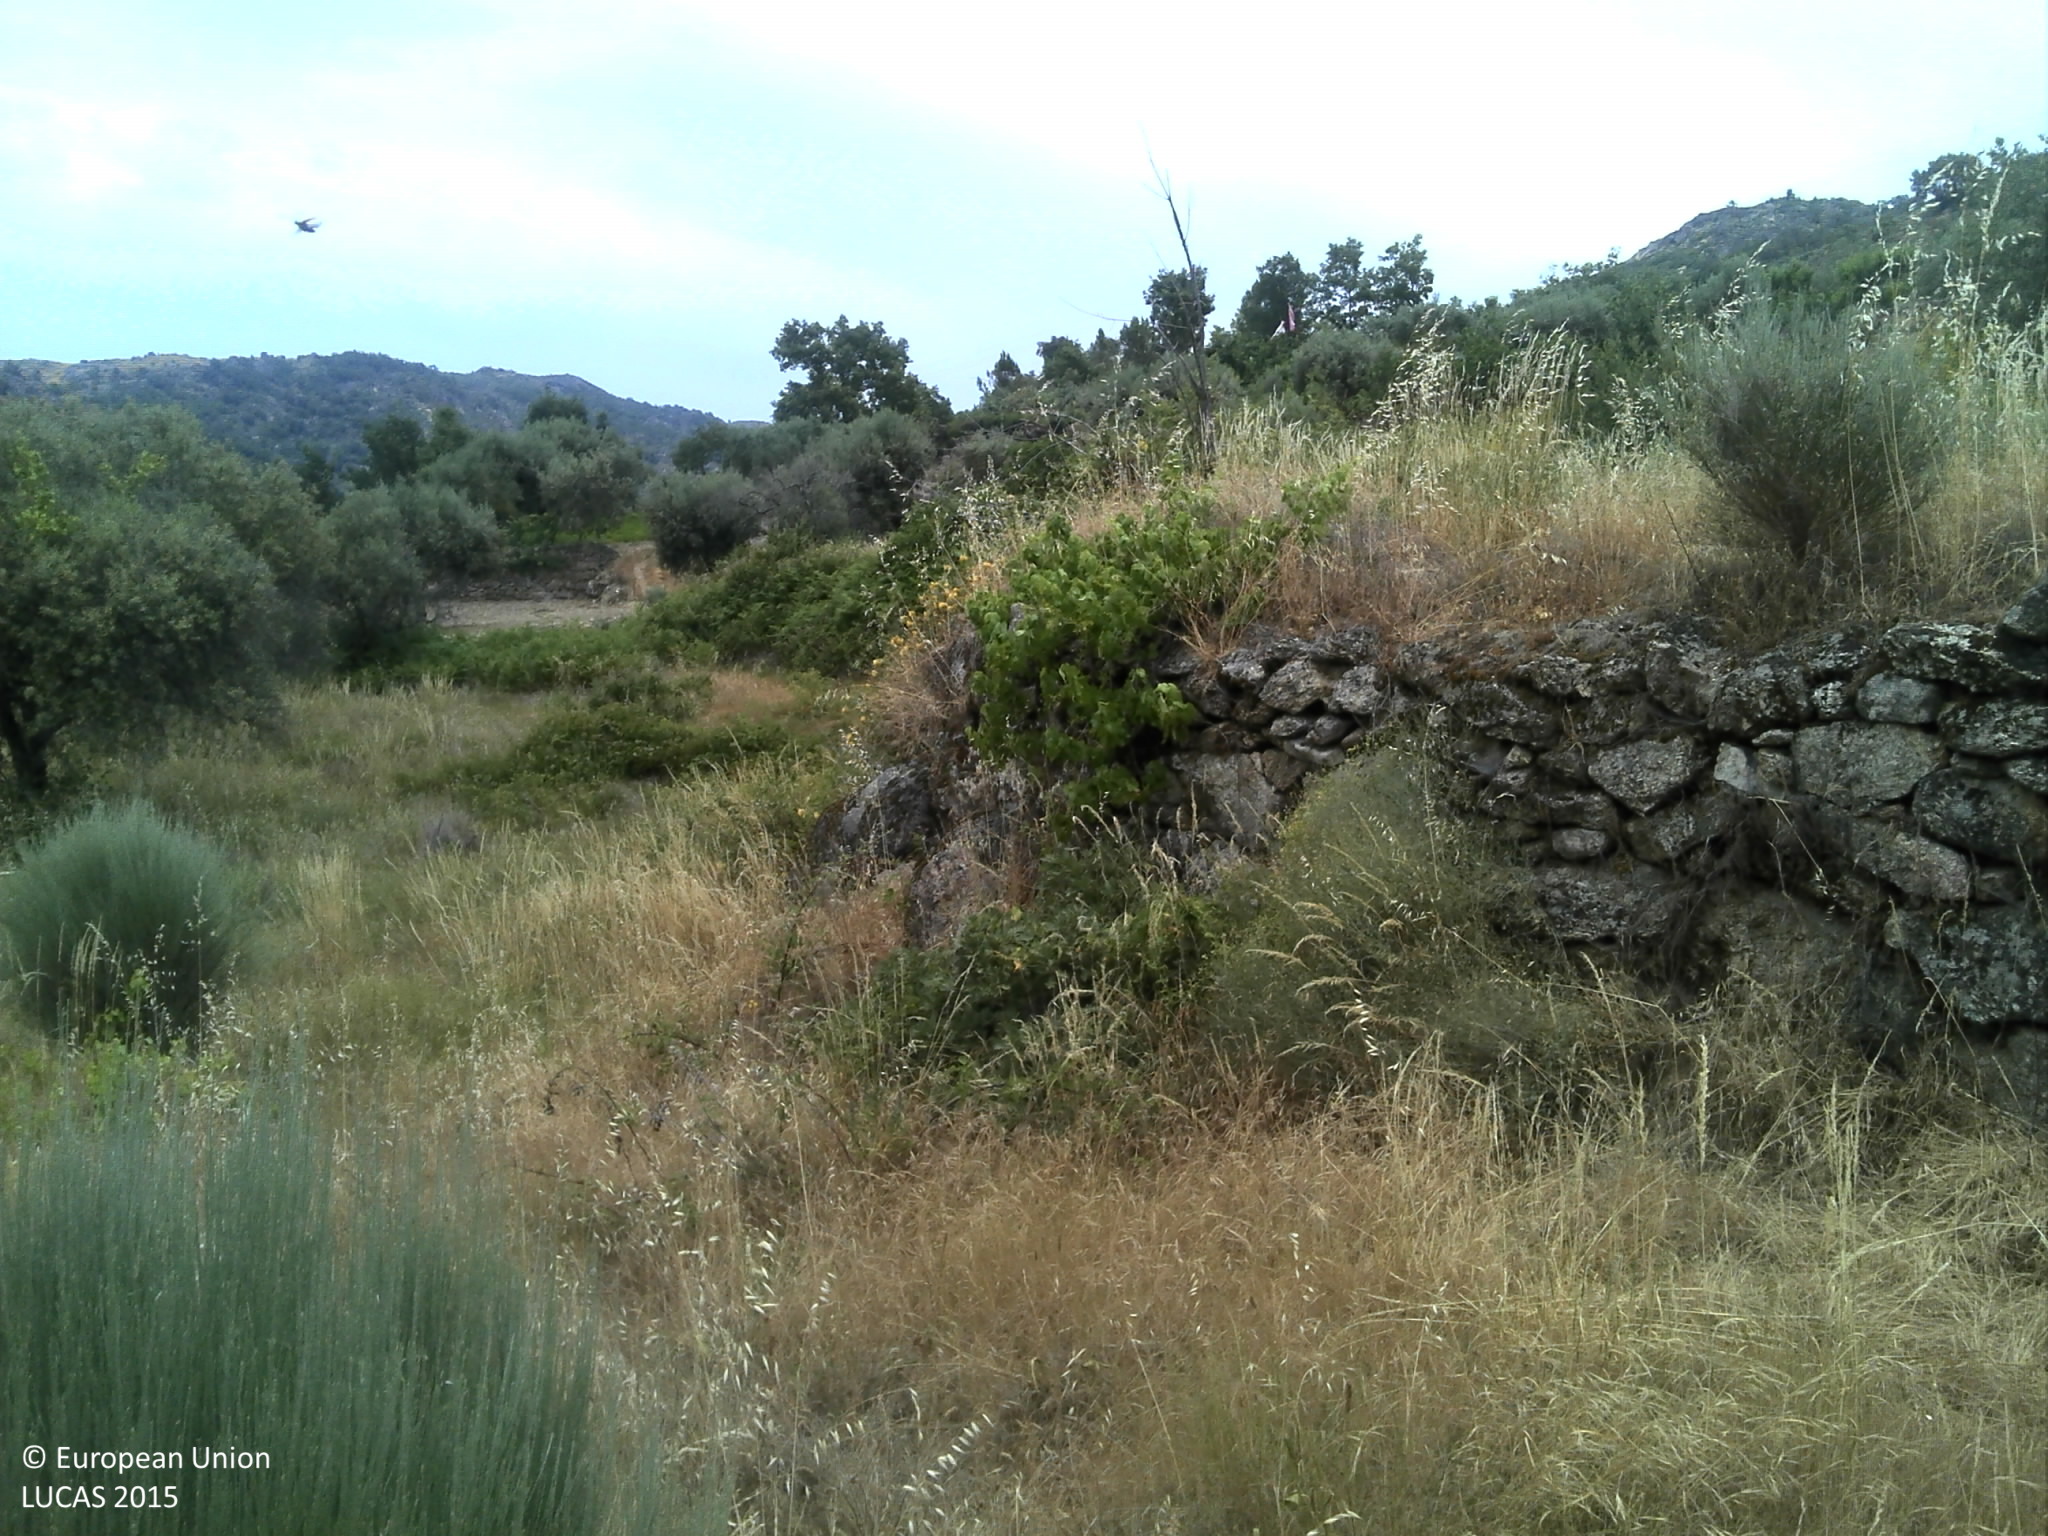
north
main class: Shrubland
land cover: Shrubland with sparse tree cover
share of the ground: 50 - 75 %
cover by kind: shrubs 55 %, herbaceous plants 30 %, broadleaved forest trees 5 %, unconsolidated bare surface 5 %
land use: Abandoned areas
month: June
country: PT
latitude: 40.3134
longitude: -7.2465
